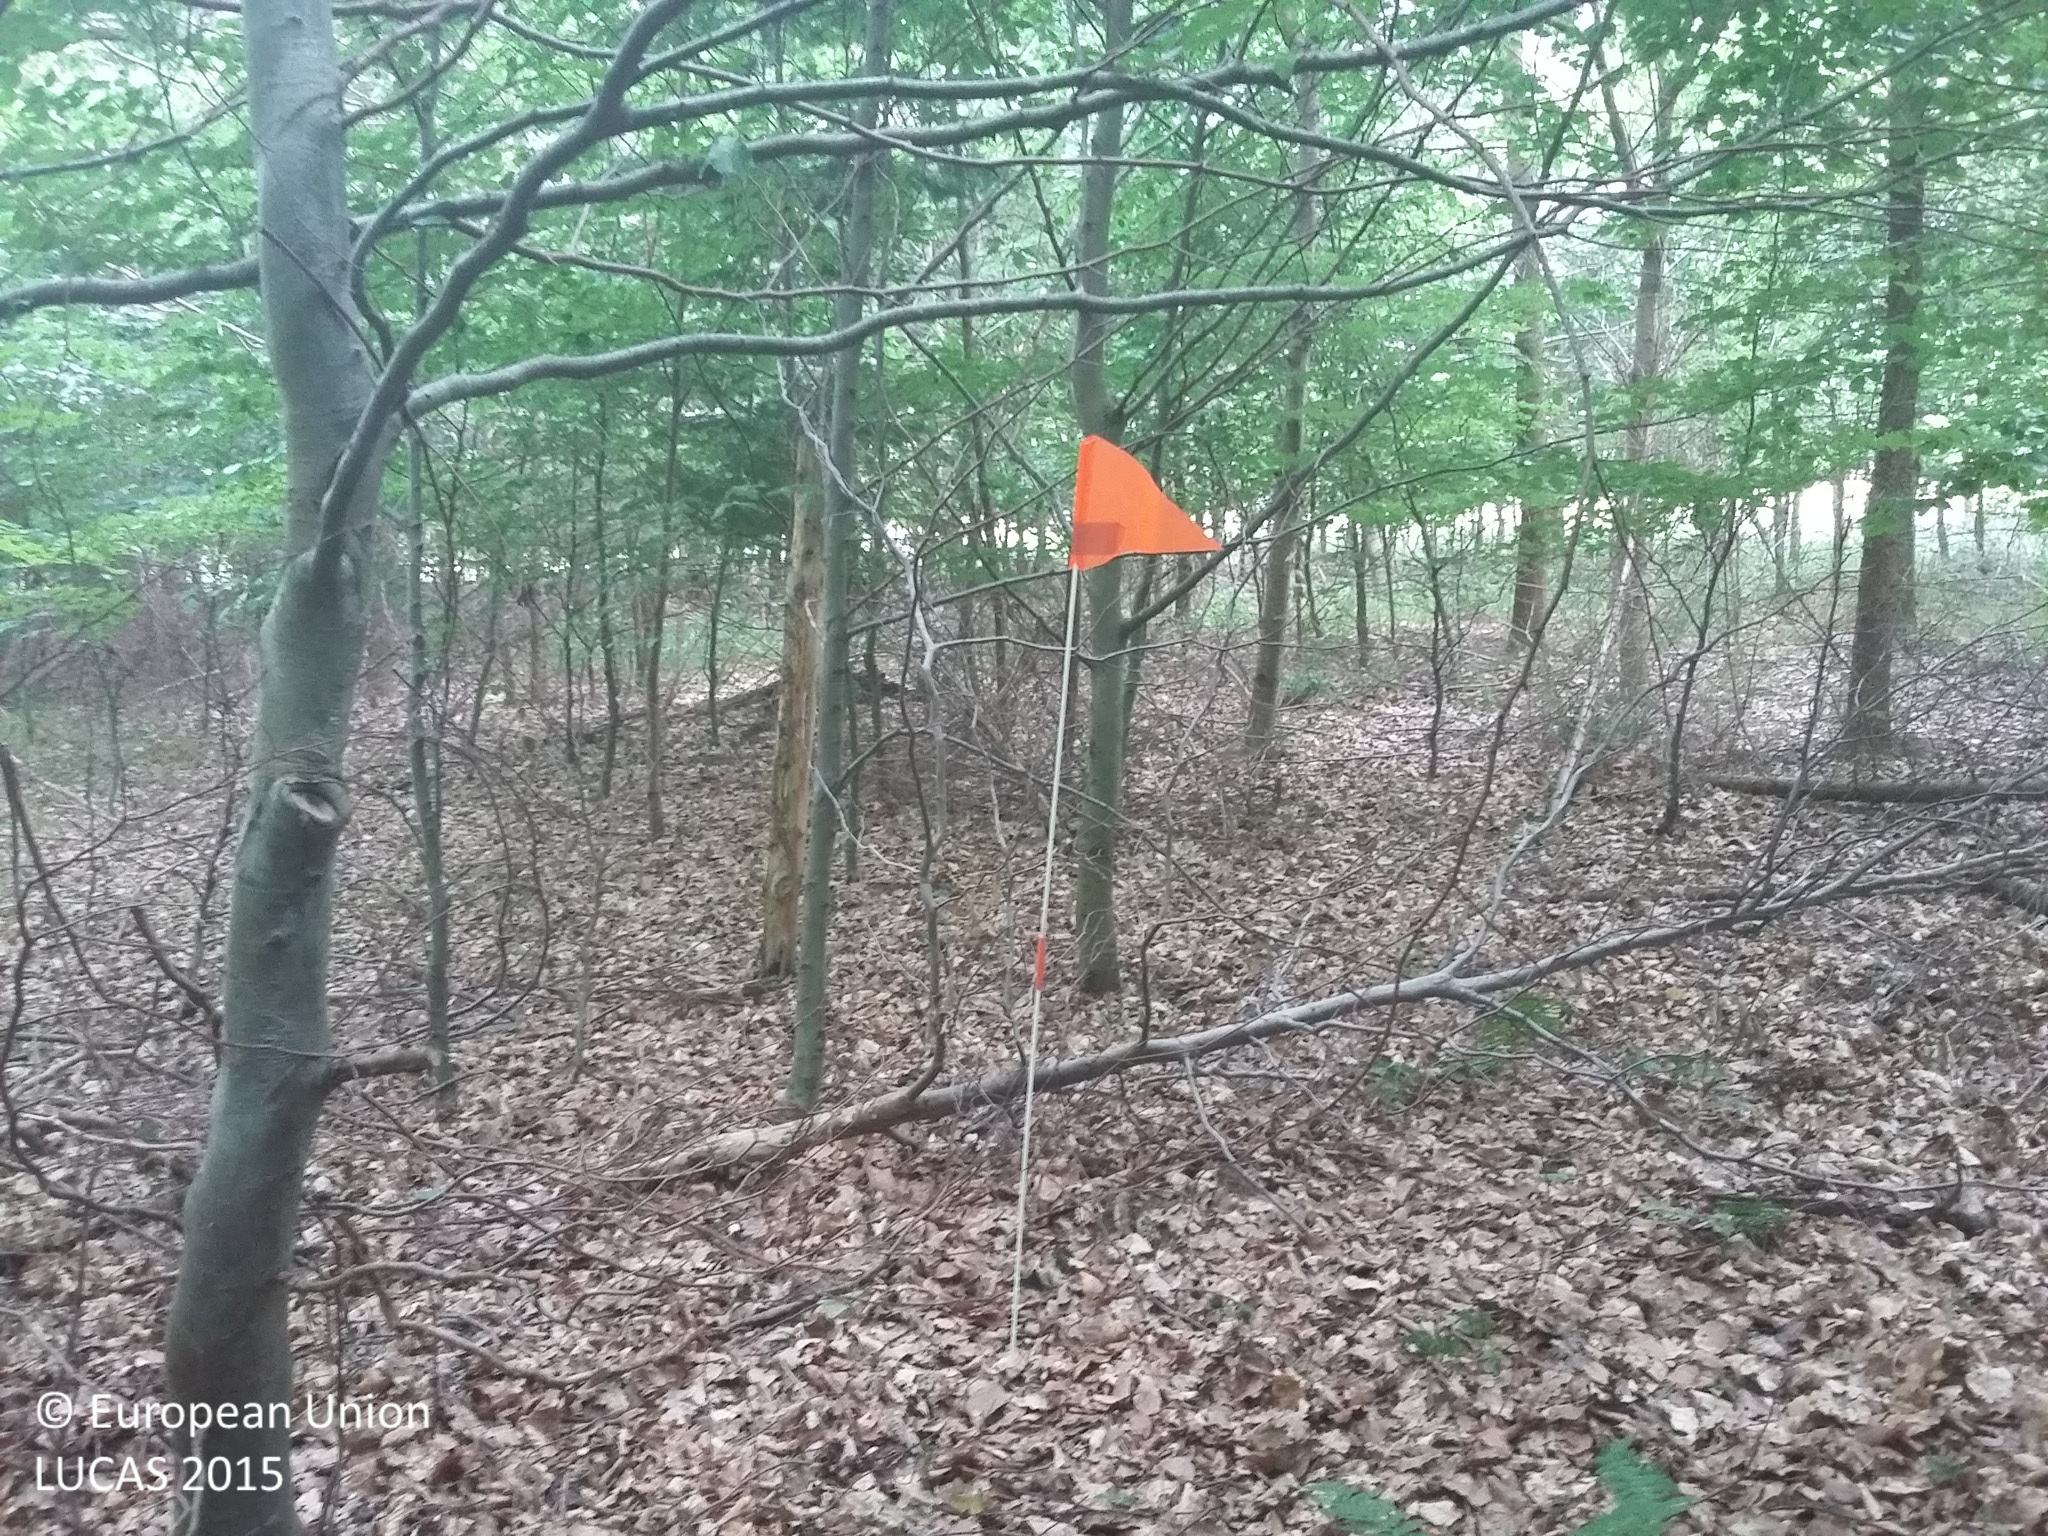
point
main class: Woodland
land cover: Broadleaved woodland
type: beech forest
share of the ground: > 75 %
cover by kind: broadleaved forest trees 95 %, unconsolidated bare surface 5 %
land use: Forestry
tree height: > 5 m
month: July
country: DK
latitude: 55.7398
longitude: 12.0528
